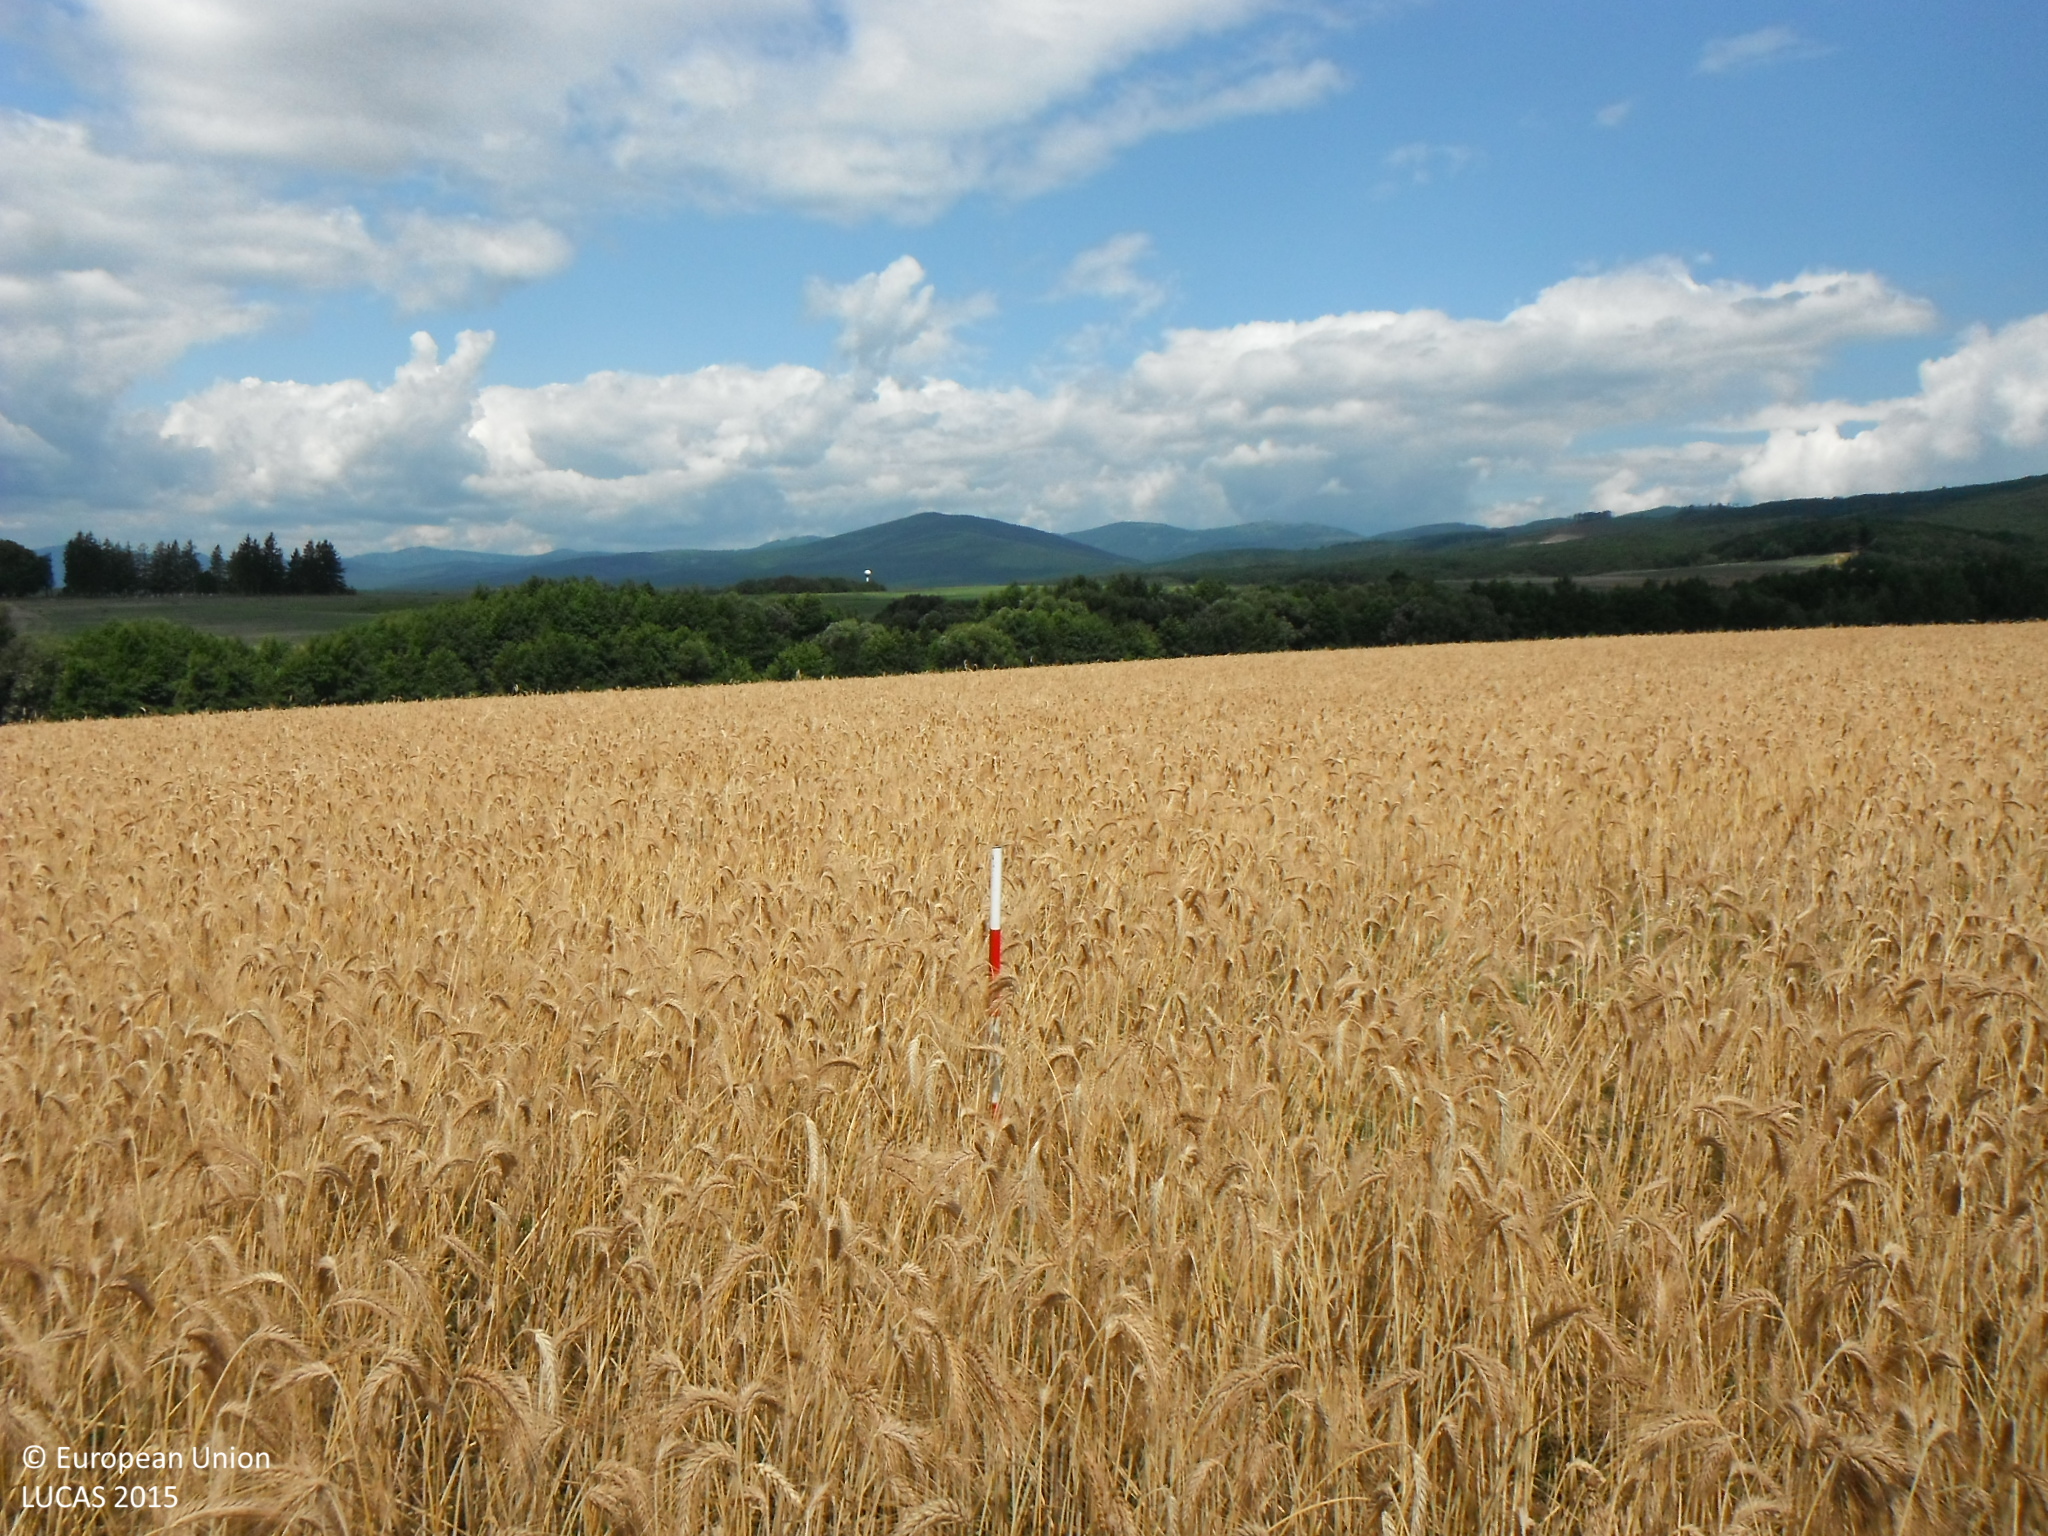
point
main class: Cropland
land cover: Triticale
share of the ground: > 75 %
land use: Agriculture (excluding fallow land and kitchen gardens)
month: July
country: SK
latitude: 48.6797
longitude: 21.0842
